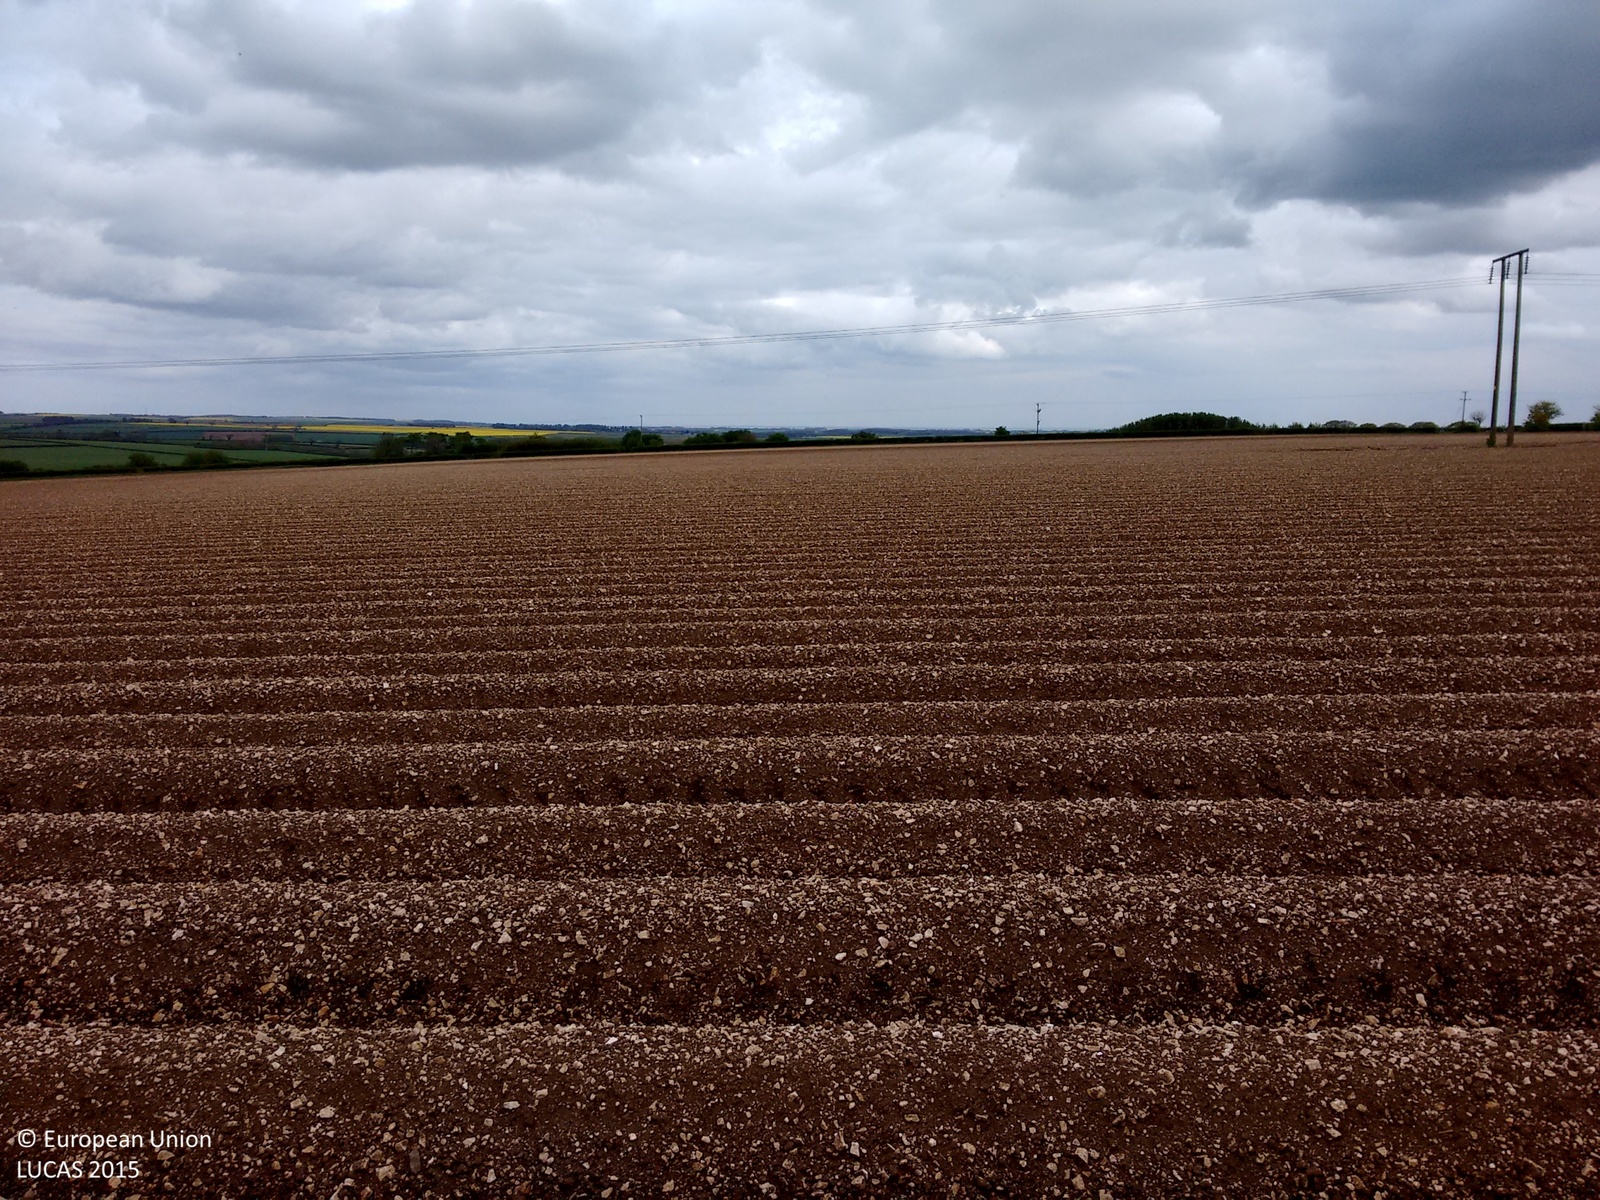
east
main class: Cropland
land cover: Potatoes
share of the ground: < 10 %
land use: Agriculture (excluding fallow land and kitchen gardens)
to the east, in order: Potatoes; Electric lines; Potatoes
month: May
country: GB
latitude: 54.0406
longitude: -0.4040
